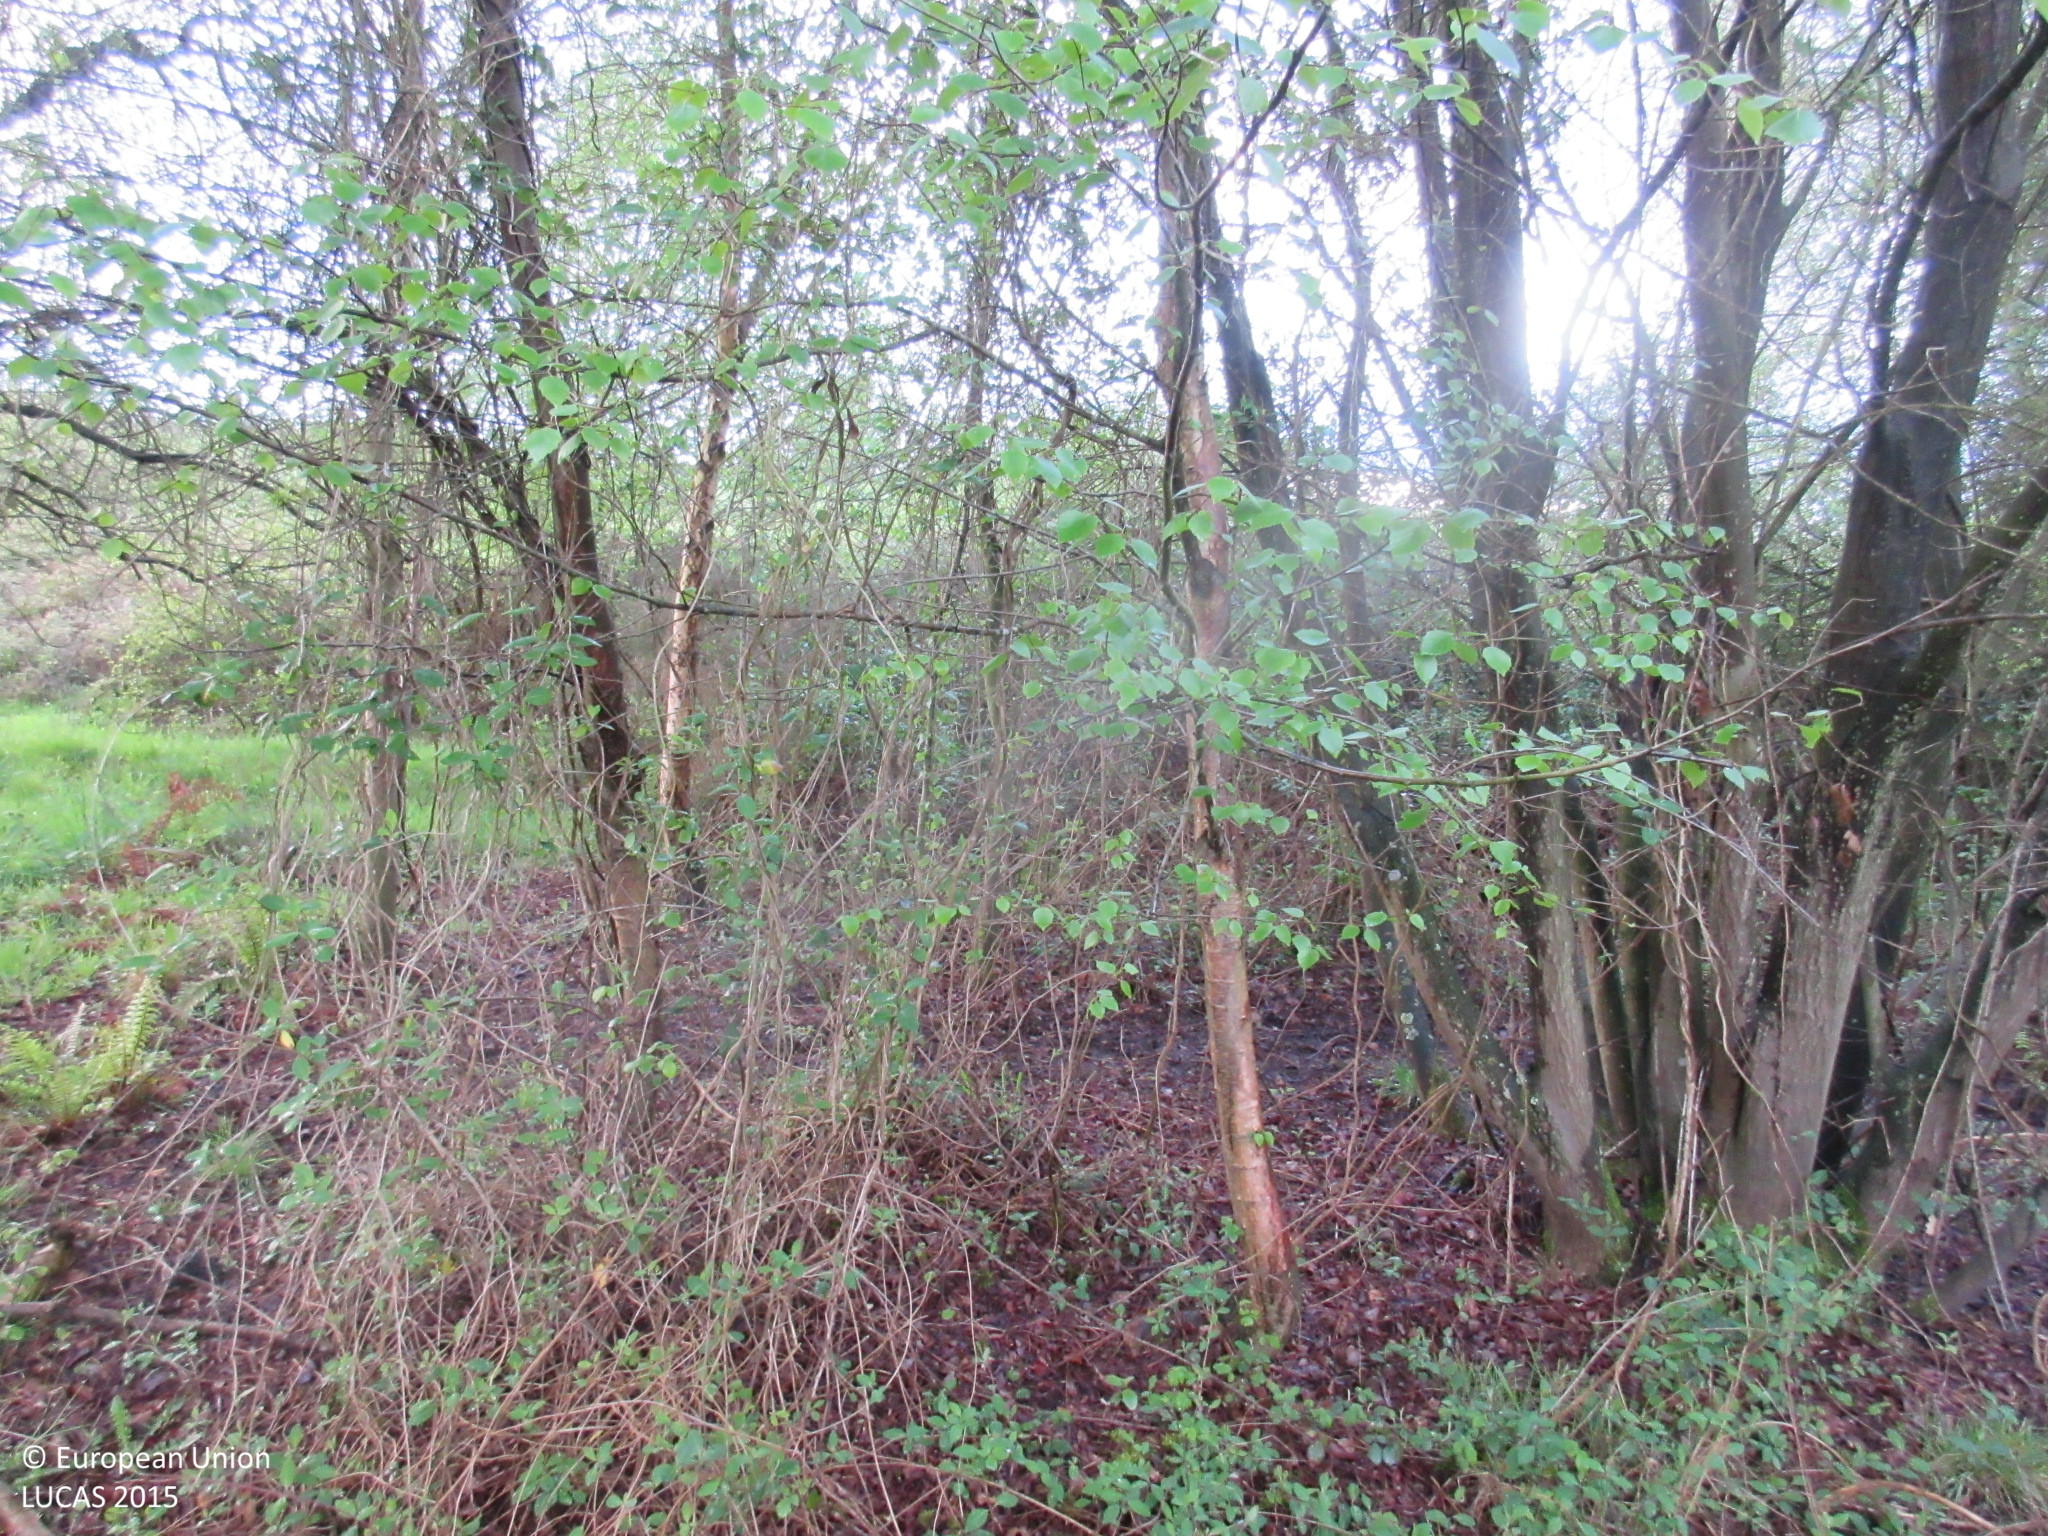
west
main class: Woodland
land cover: Broadleaved woodland
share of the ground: > 75 %
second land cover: Shrubland without tree cover
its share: 10 - 25 %
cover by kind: broadleaved forest trees 80 %, shrubs 10 %, herbaceous plants 10 %
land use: Forestry
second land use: Agriculture (excluding fallow land and kitchen gardens)
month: April
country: ES
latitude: 43.5186
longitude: -5.3067
